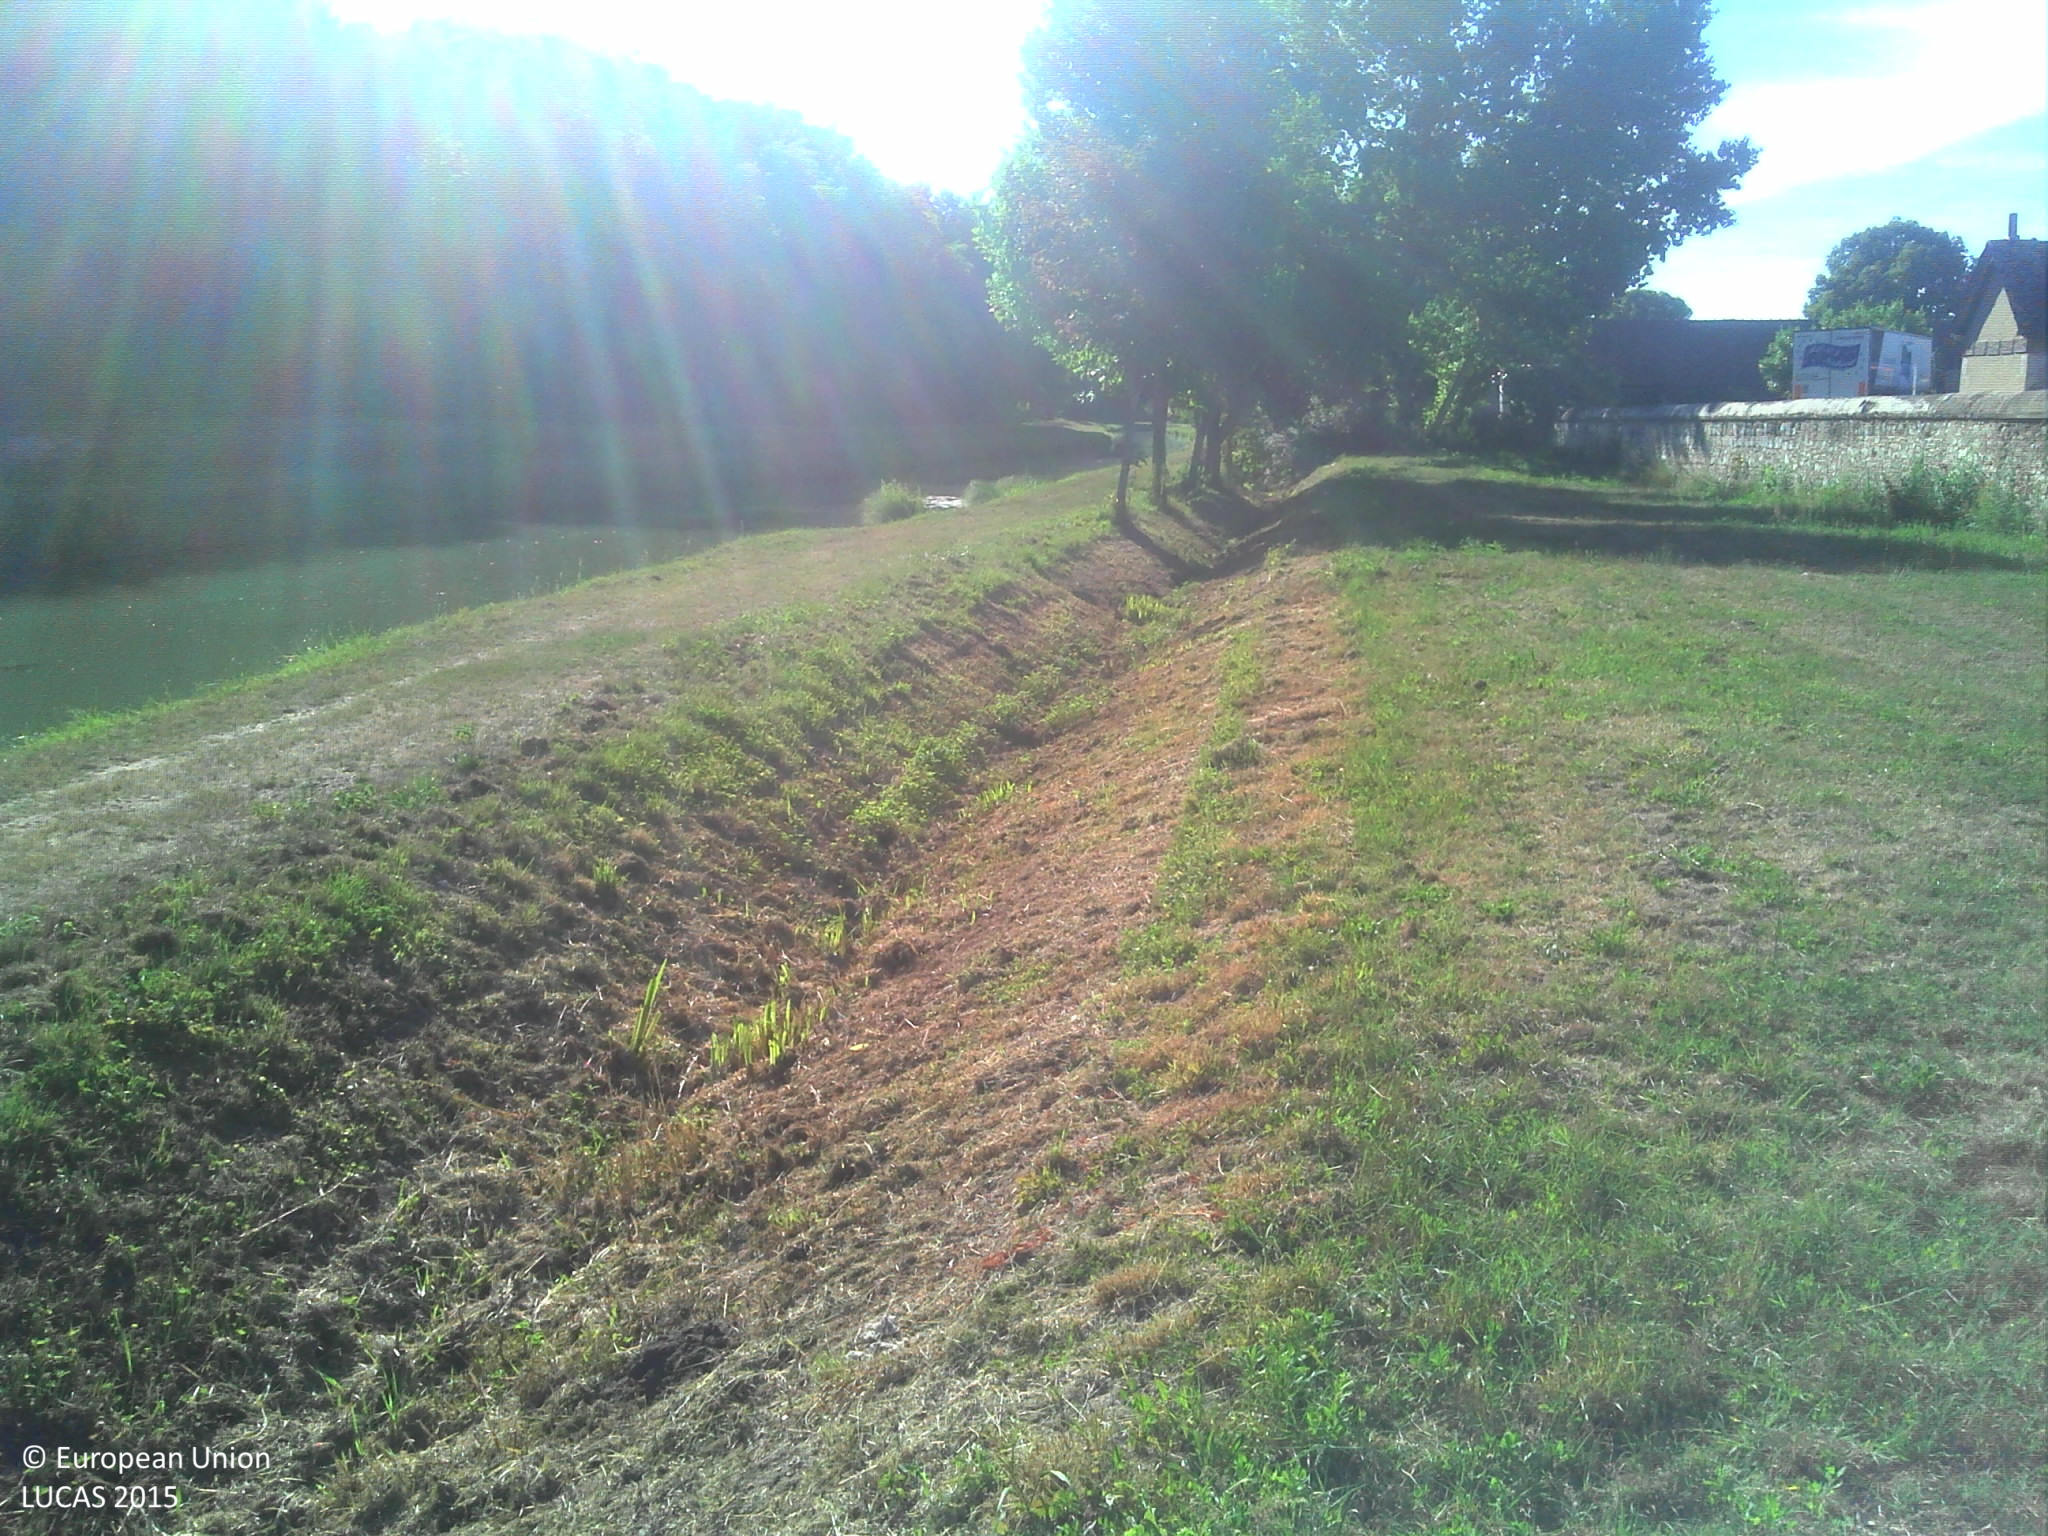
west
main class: Grassland
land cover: Grassland without tree/shrub cover
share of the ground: > 75 %
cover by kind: herbaceous plants 100 %
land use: Amenities, museums, leisure
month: June
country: FR
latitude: 47.2723
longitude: 1.4076
